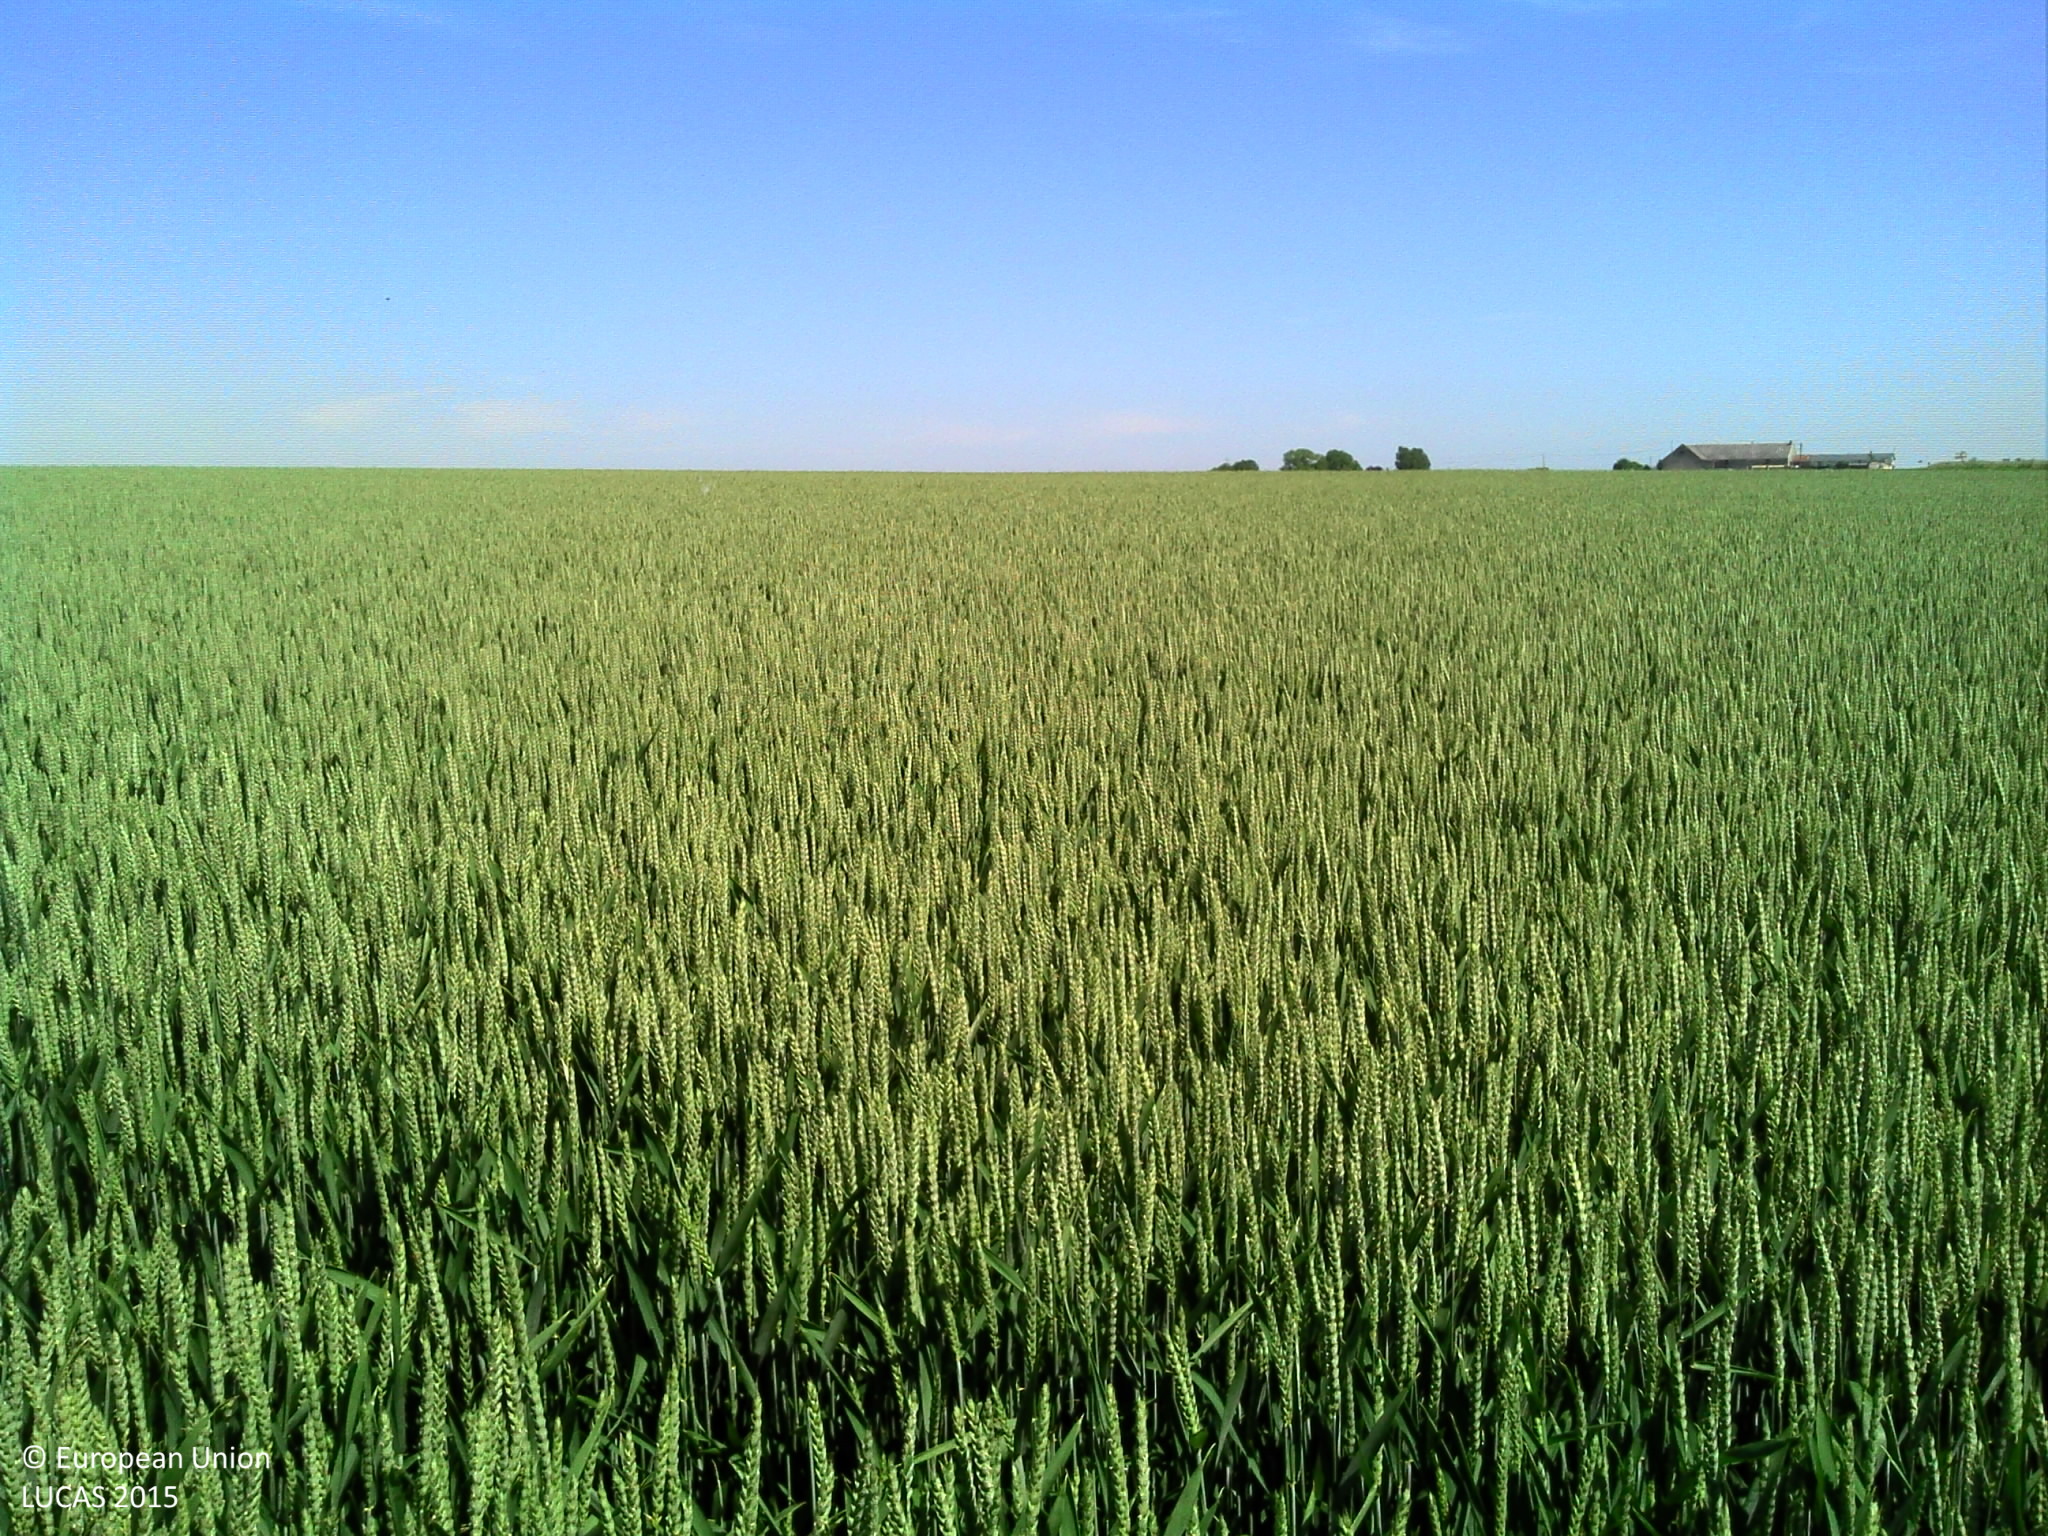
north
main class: Cropland
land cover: Common wheat
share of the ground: > 75 %
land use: Agriculture (excluding fallow land and kitchen gardens)
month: June
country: FR
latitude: 49.4247
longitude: 3.2501
